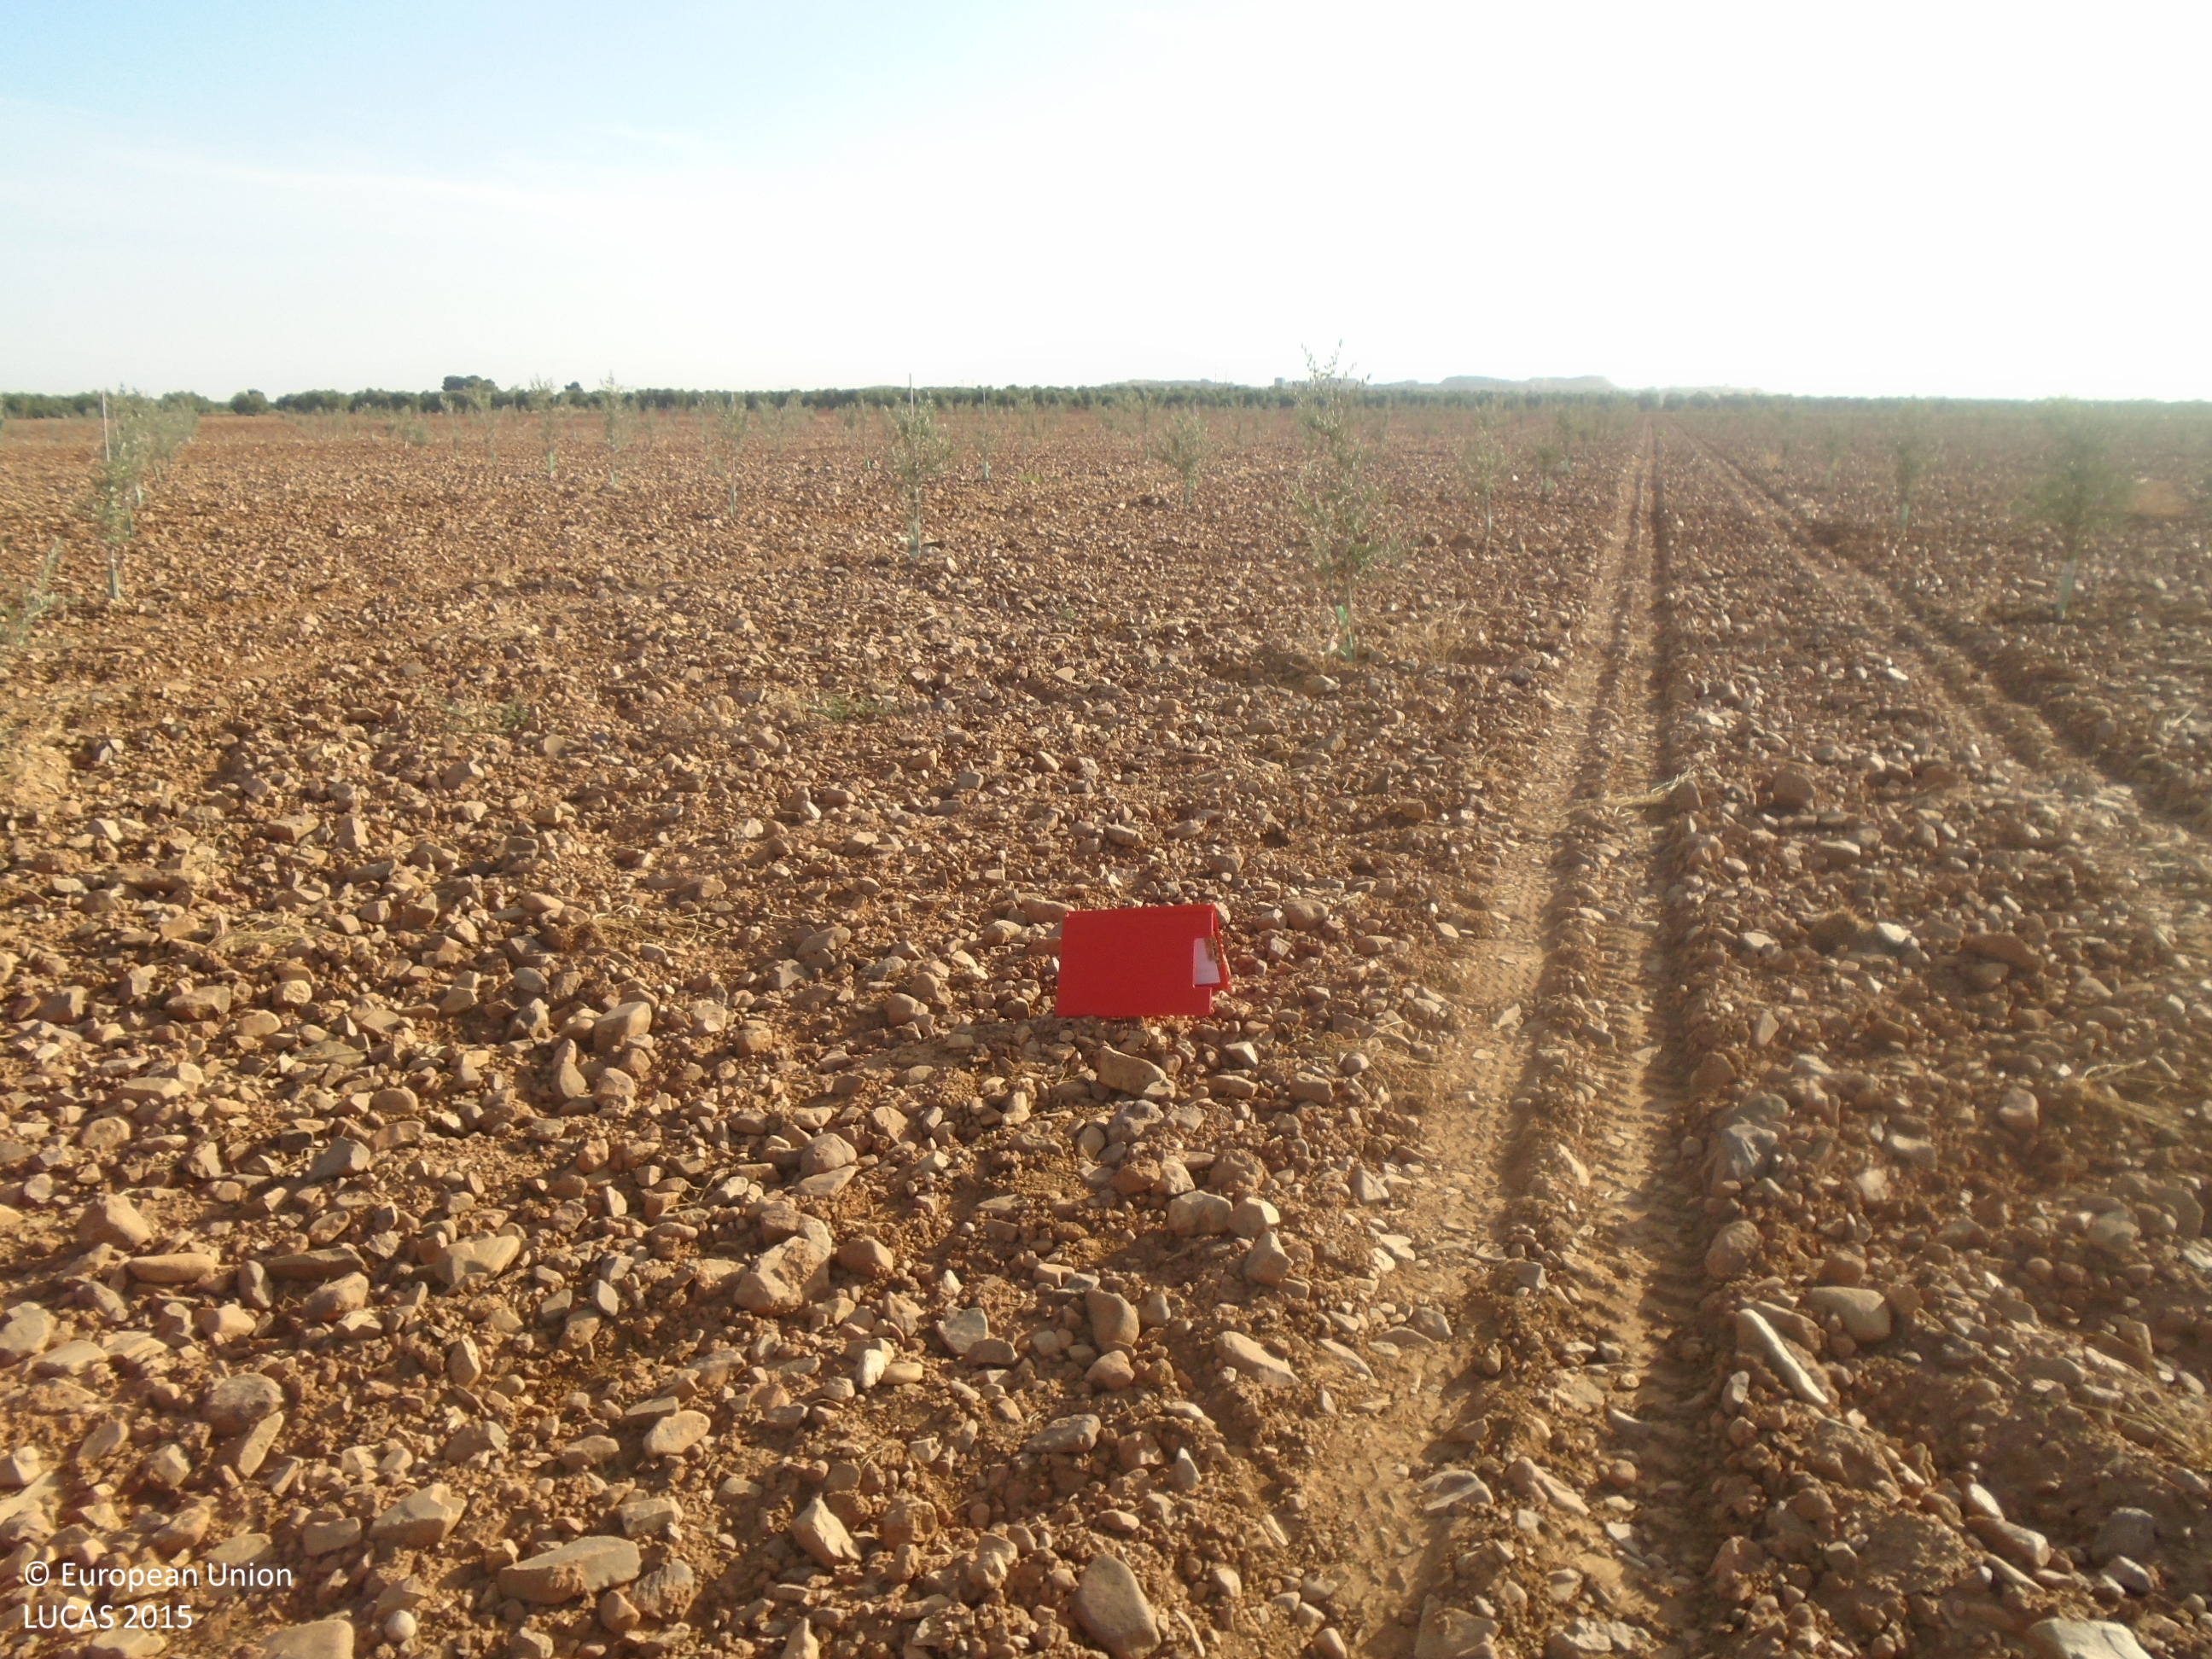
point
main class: Cropland
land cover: Olive groves
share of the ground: < 10 %
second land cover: Other bare soil
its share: > 75 %
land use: Agriculture (excluding fallow land and kitchen gardens)
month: July
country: ES
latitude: 39.3457
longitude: -3.5154
